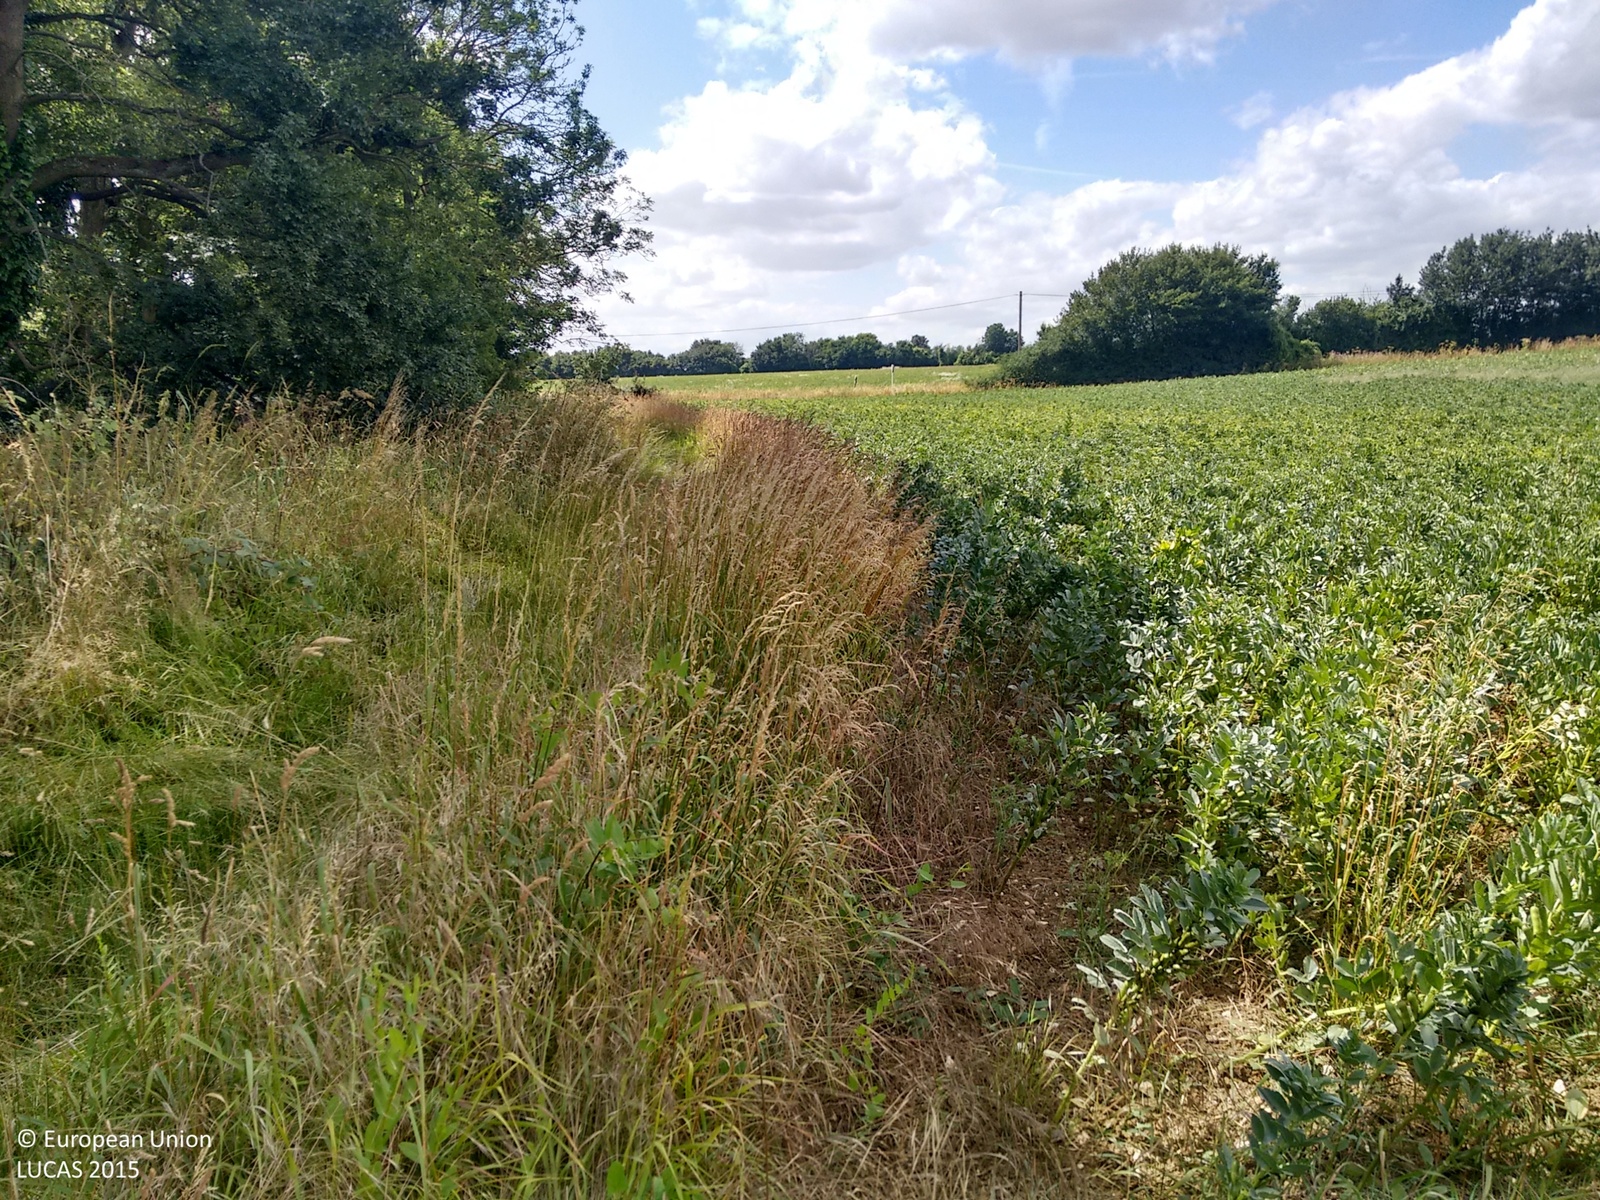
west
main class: Cropland
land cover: Dry pulses
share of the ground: > 75 %
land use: Agriculture (excluding fallow land and kitchen gardens)
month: July
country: GB
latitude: 51.8076
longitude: 0.4135
